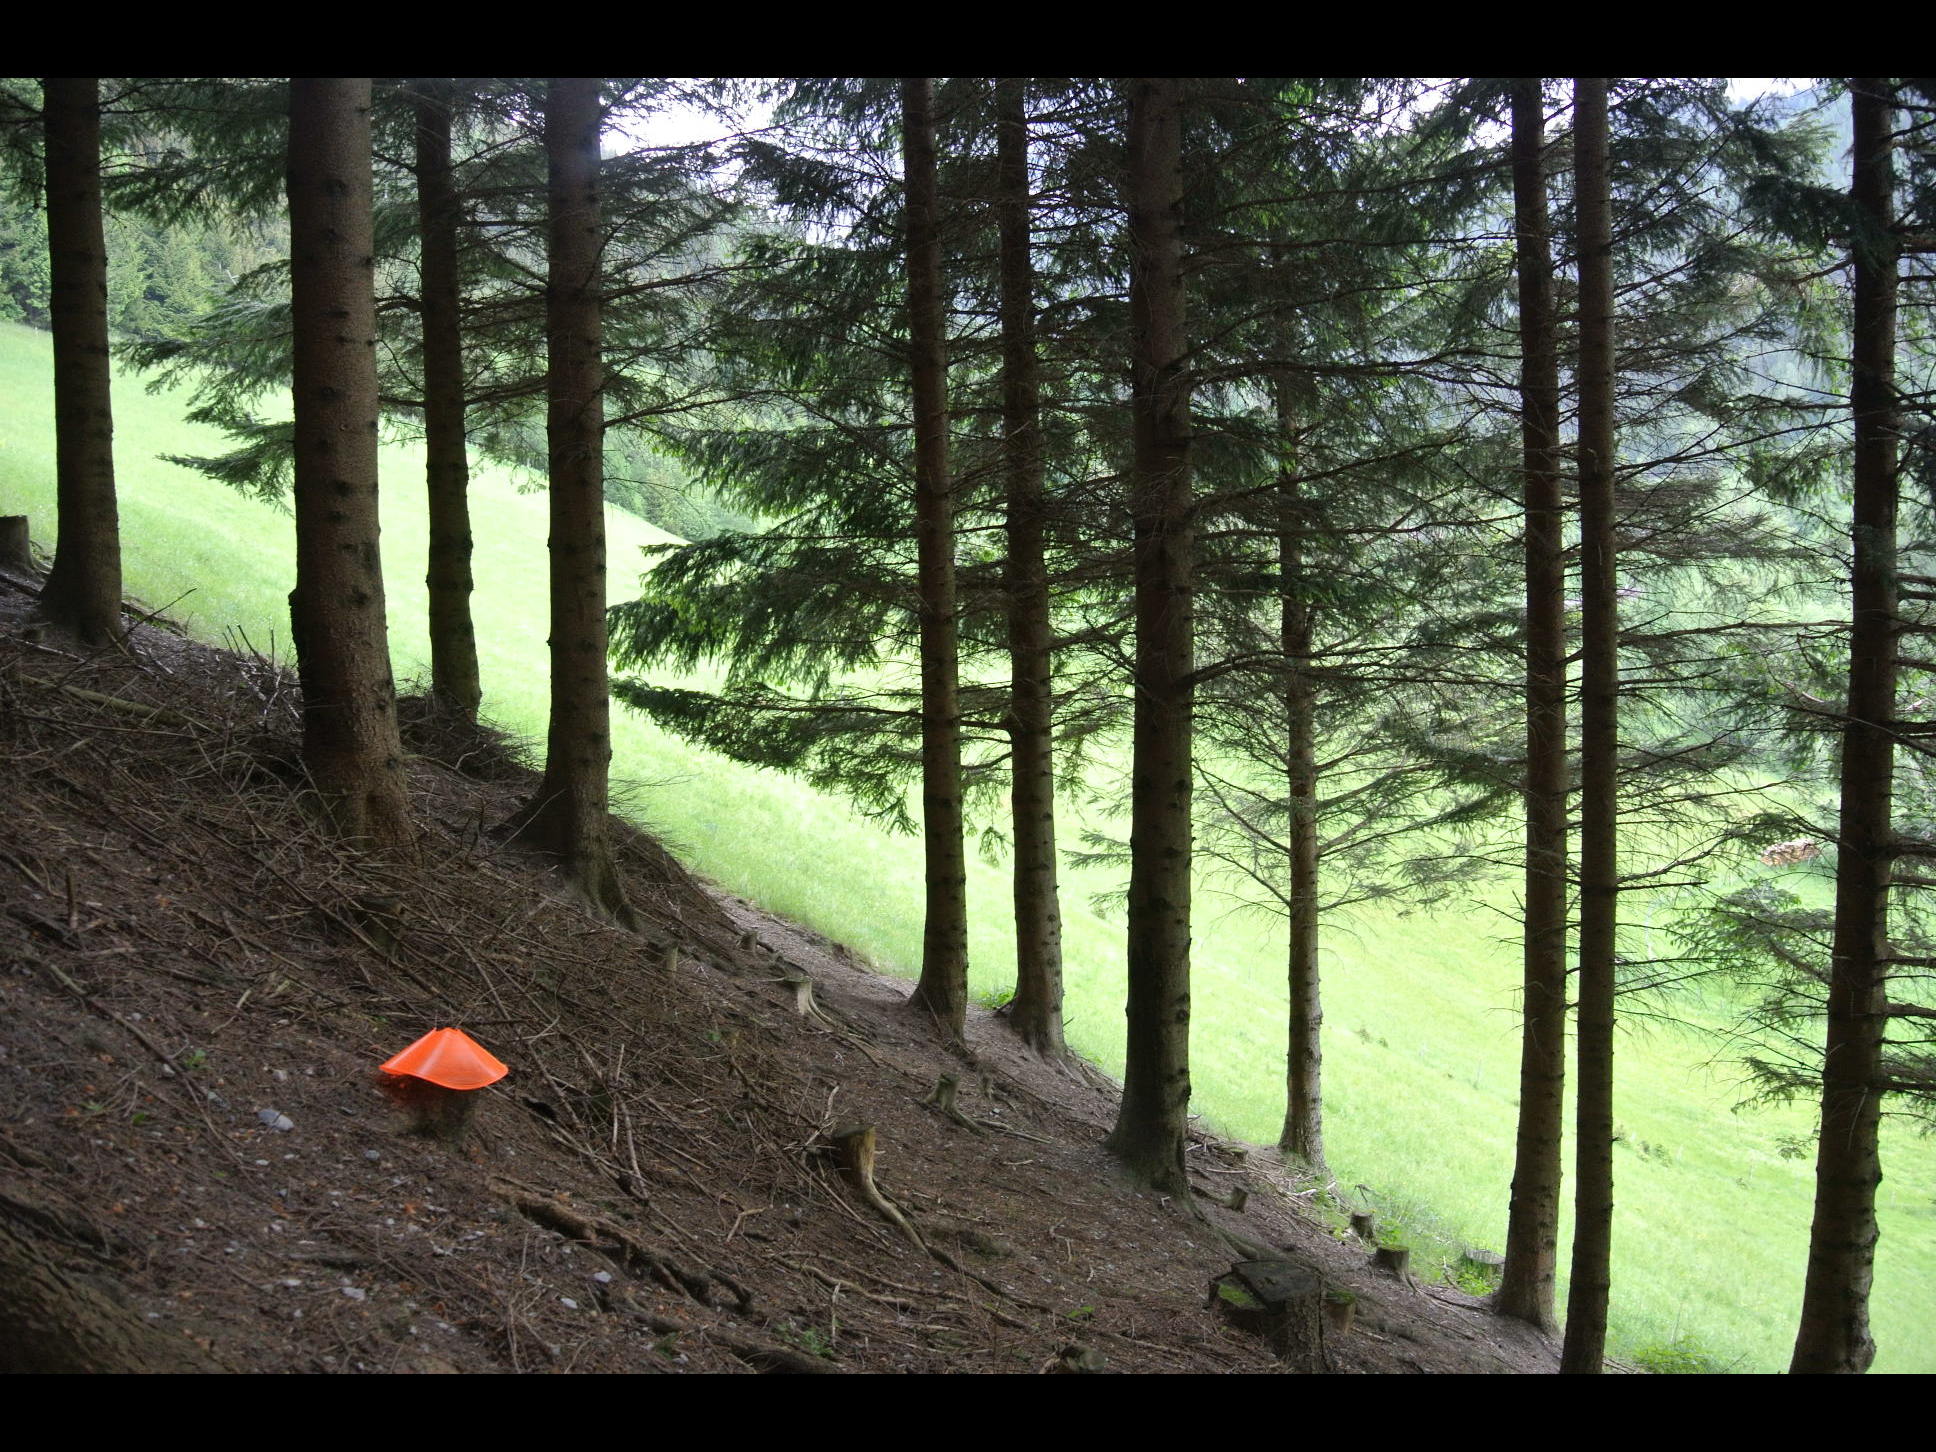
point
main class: Woodland
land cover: Spruce dominated coniferous woodland
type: alpine coniferous forest
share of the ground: > 75 %
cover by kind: coniferous forest trees 100 %
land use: Forestry
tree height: > 5 m
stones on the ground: 10 - 25 %
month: May
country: AT
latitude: 47.6770
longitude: 15.7428
